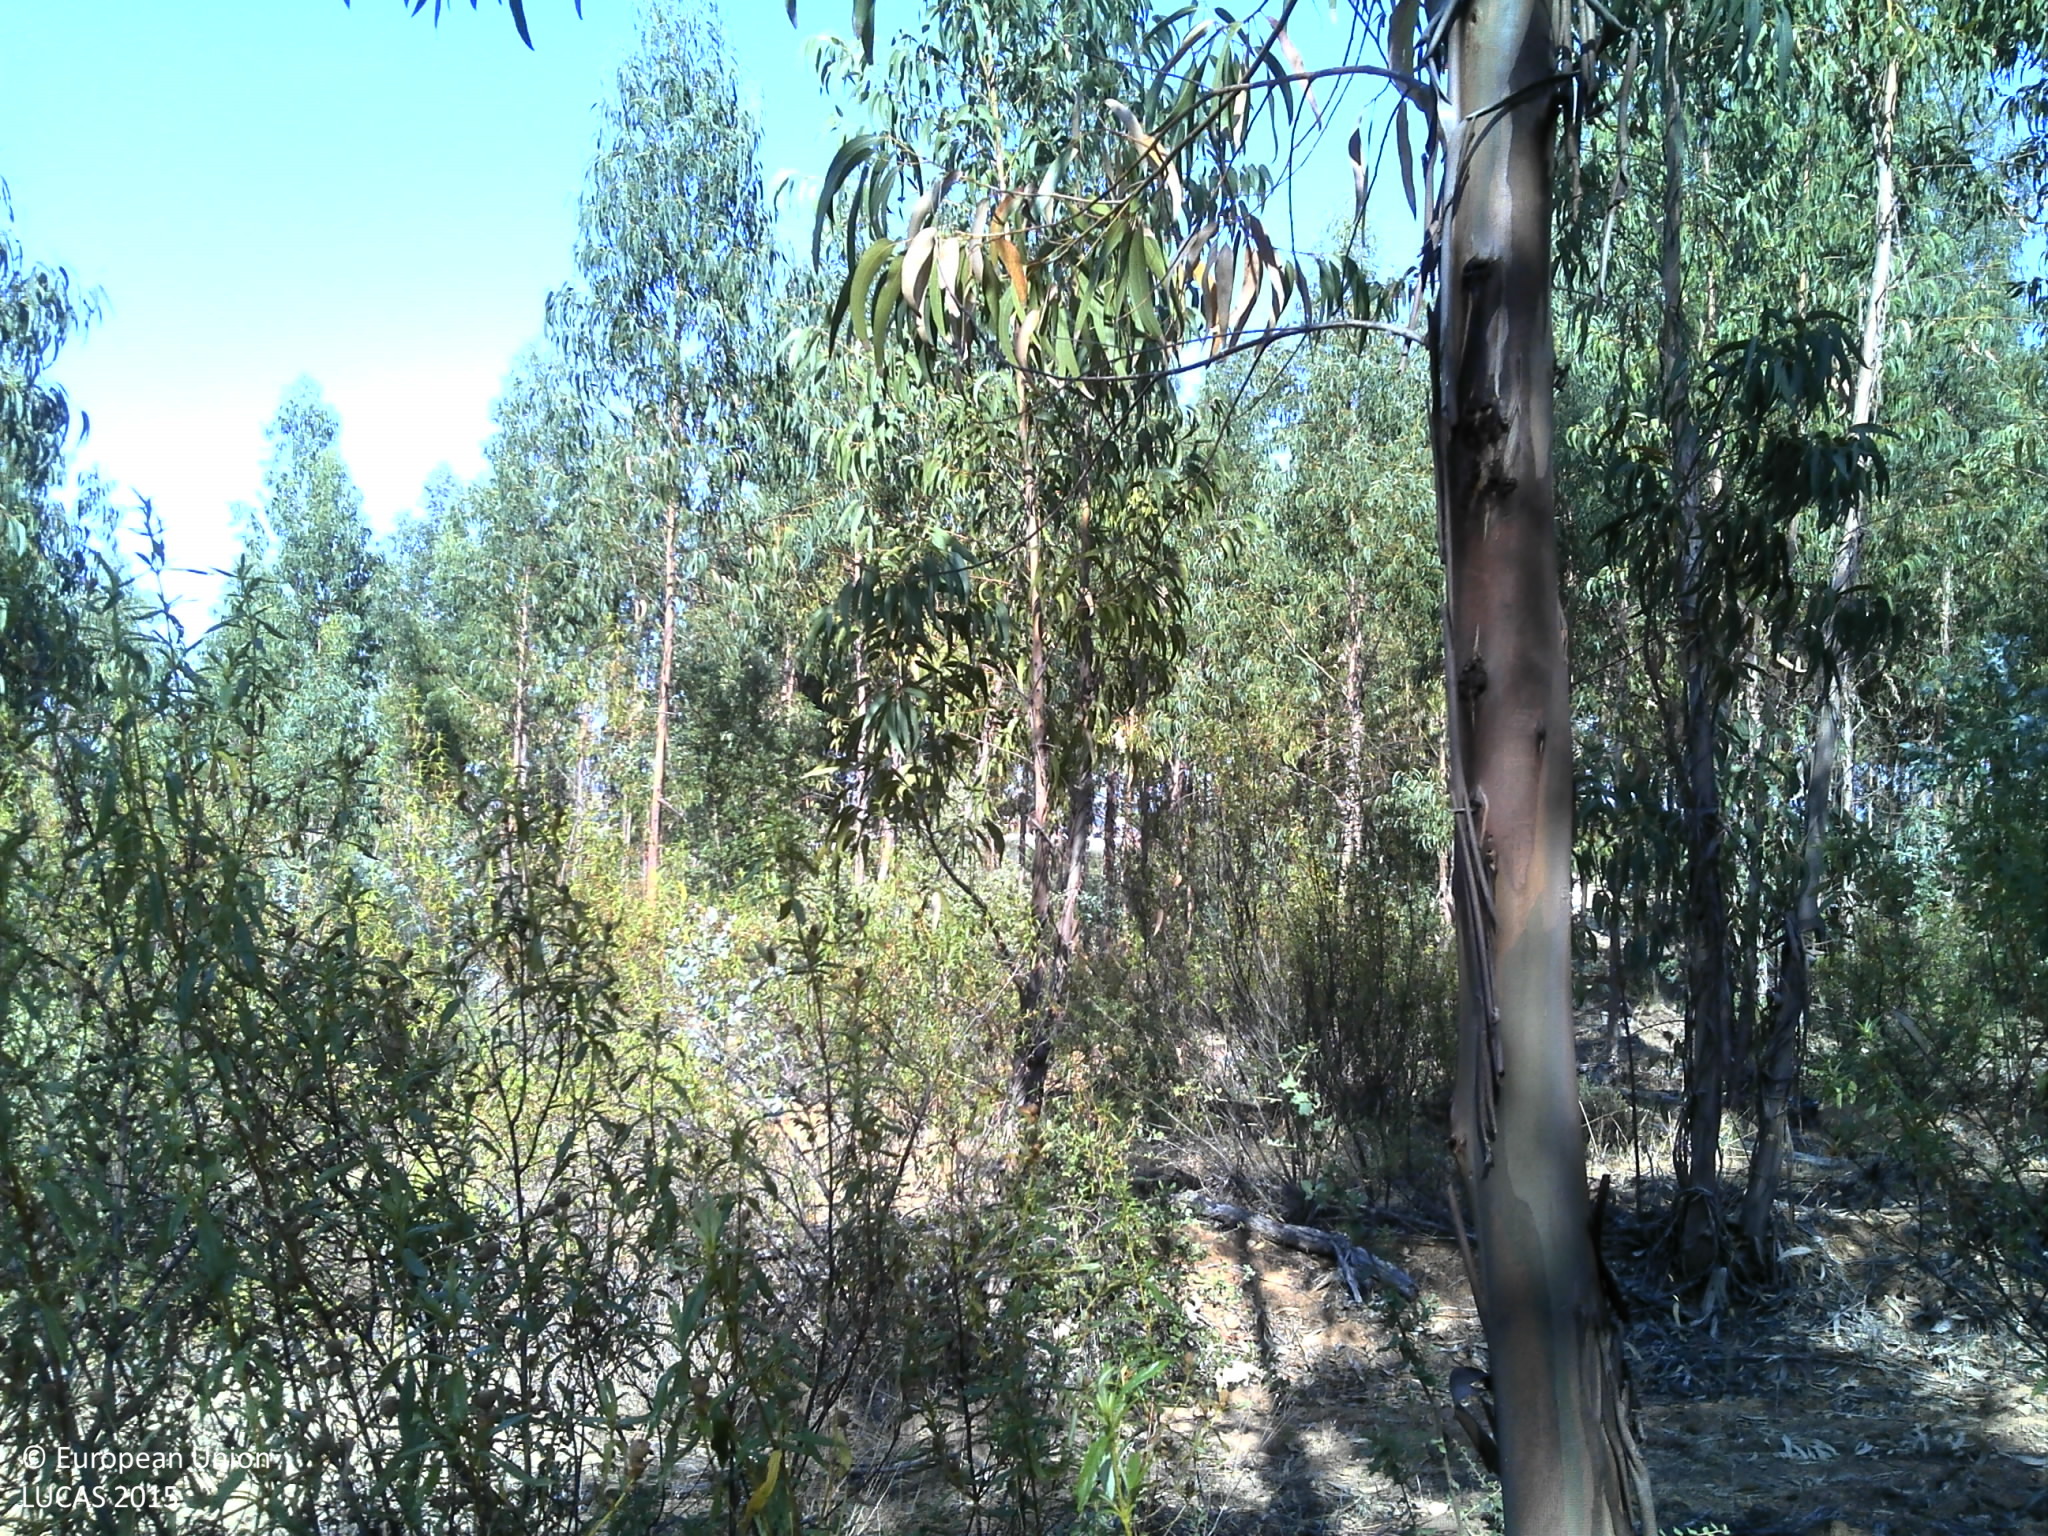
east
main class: Woodland
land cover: Broadleaved woodland
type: exotic forest
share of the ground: 50 - 75 %
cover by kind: broadleaved forest trees 75 %, shrubs 15 %, unconsolidated bare surface 10 %
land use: Forestry
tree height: > 5 m
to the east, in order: Broadleaved woodland; Fences; Tracks; Grassland without tree/shrub cover; Fences; Broadleaved woodland; Fences; Grass margins; Tracks; Dry stone walls; Abandoned hedges; Grass margins; Paved roads, cycling and walking lanes; Grassland without tree/shrub cover; Abandoned hedges
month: July
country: PT
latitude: 38.7346
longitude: -7.5074
